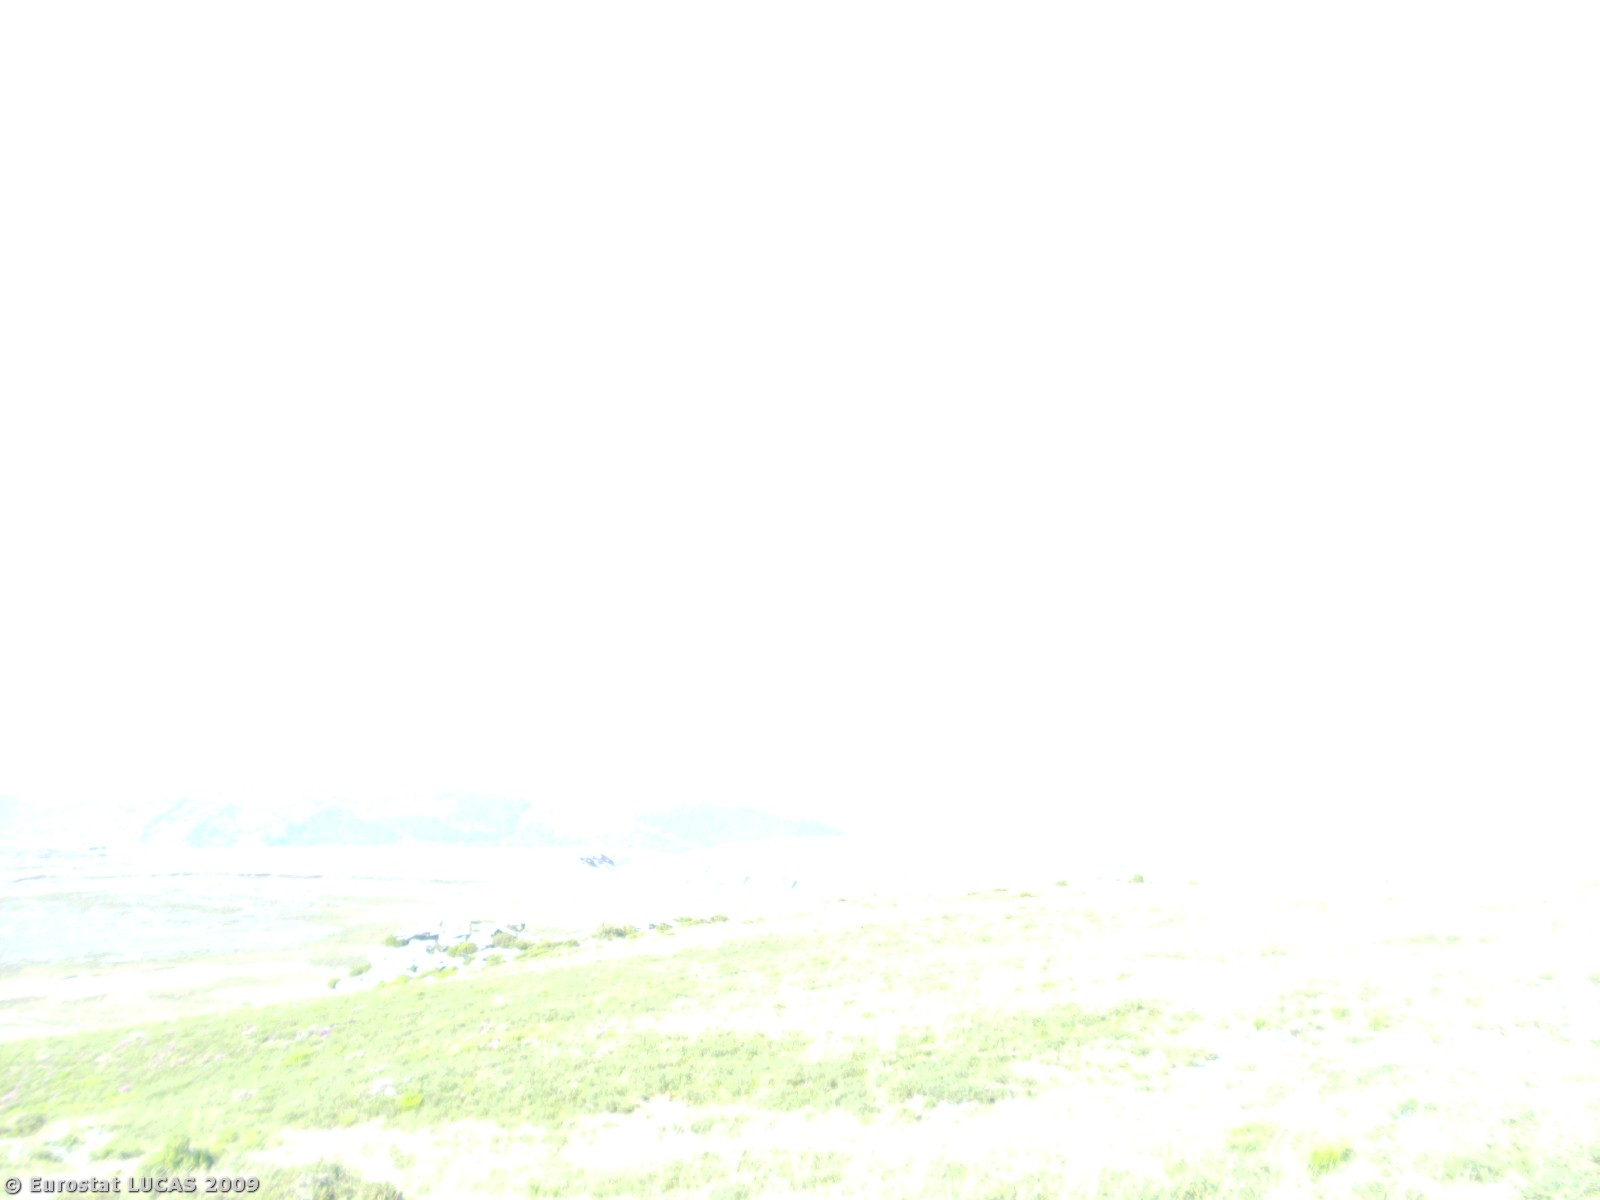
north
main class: Shrubland
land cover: Shrubland without tree cover
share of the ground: > 75 %
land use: Nature reserves
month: August
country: PT
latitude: 41.2991
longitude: -7.9178
